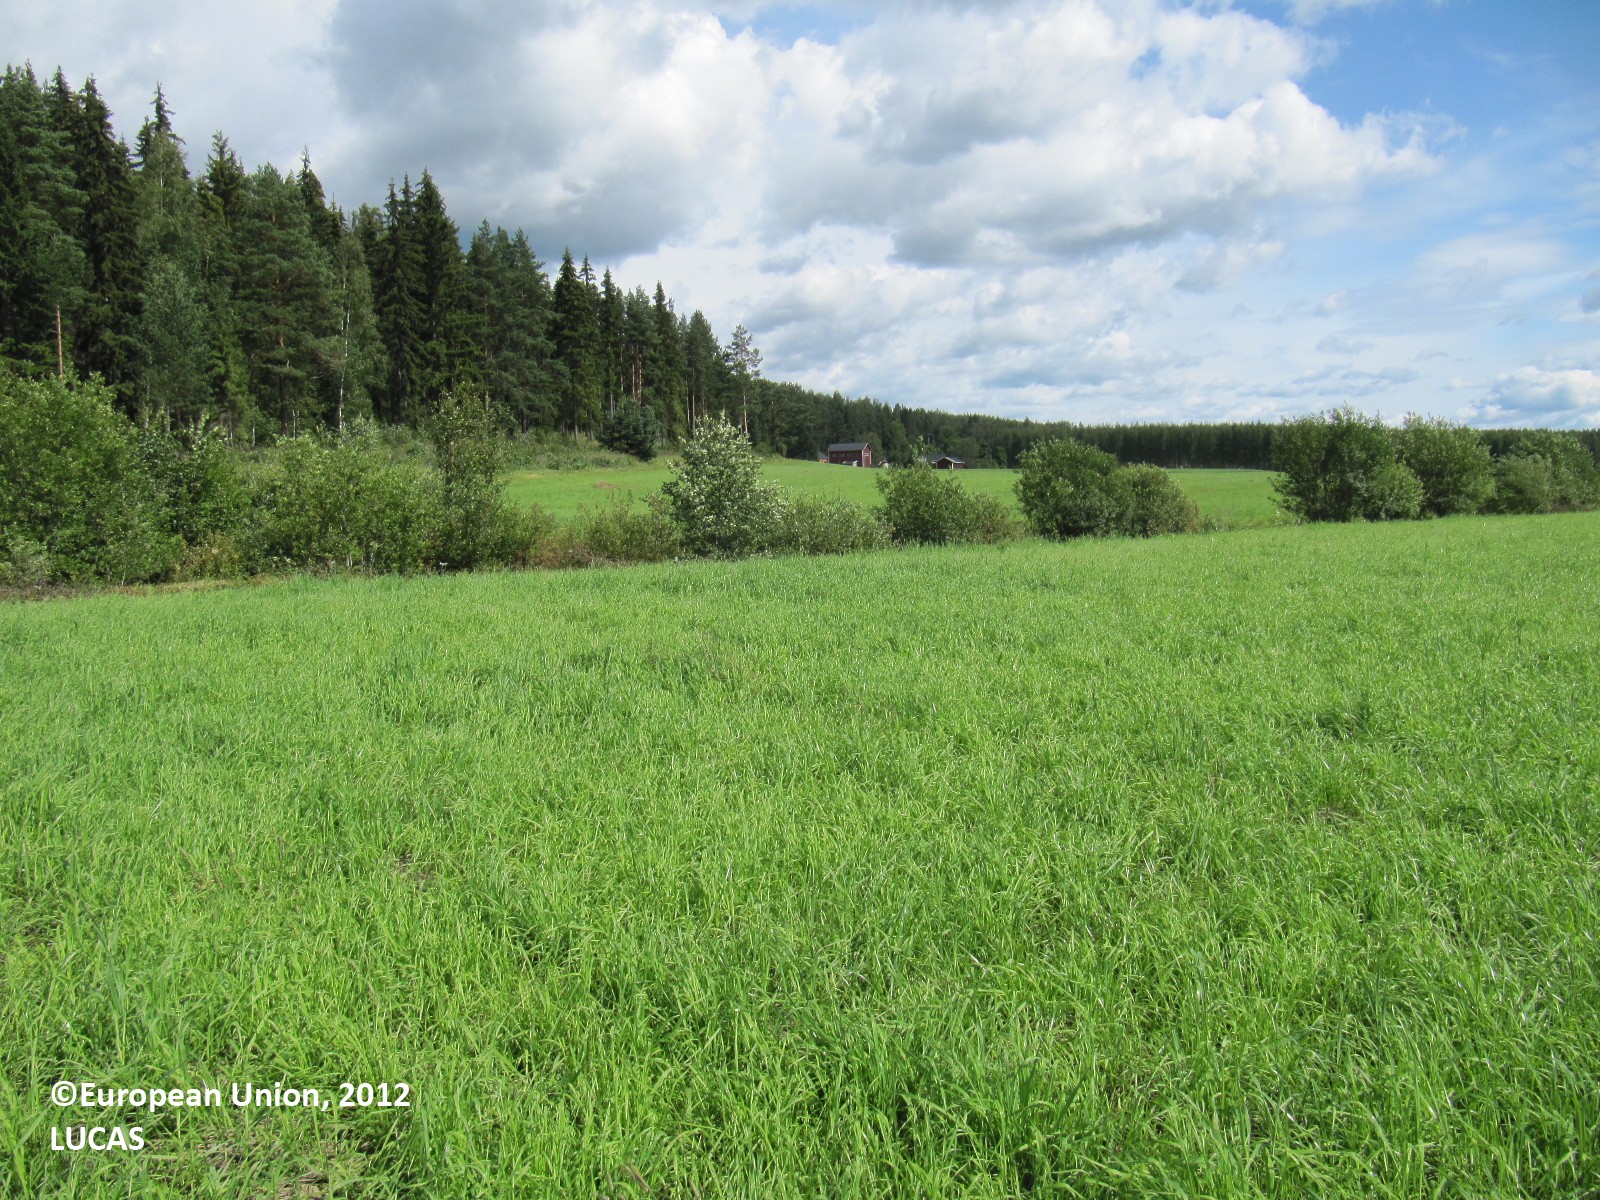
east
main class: Grassland
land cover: Spontaneously vegetated surfaces
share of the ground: > 75 %
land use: Agriculture (excluding fallow land and kitchen gardens)
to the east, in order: Spontaneously vegetated surfaces; Ditches and canals; Grassland without tree/shrub cover; Shrubland with sparse tree cover; Tracks; Spruce dominated coniferous woodland
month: July
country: FI
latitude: 61.1404
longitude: 24.6092
